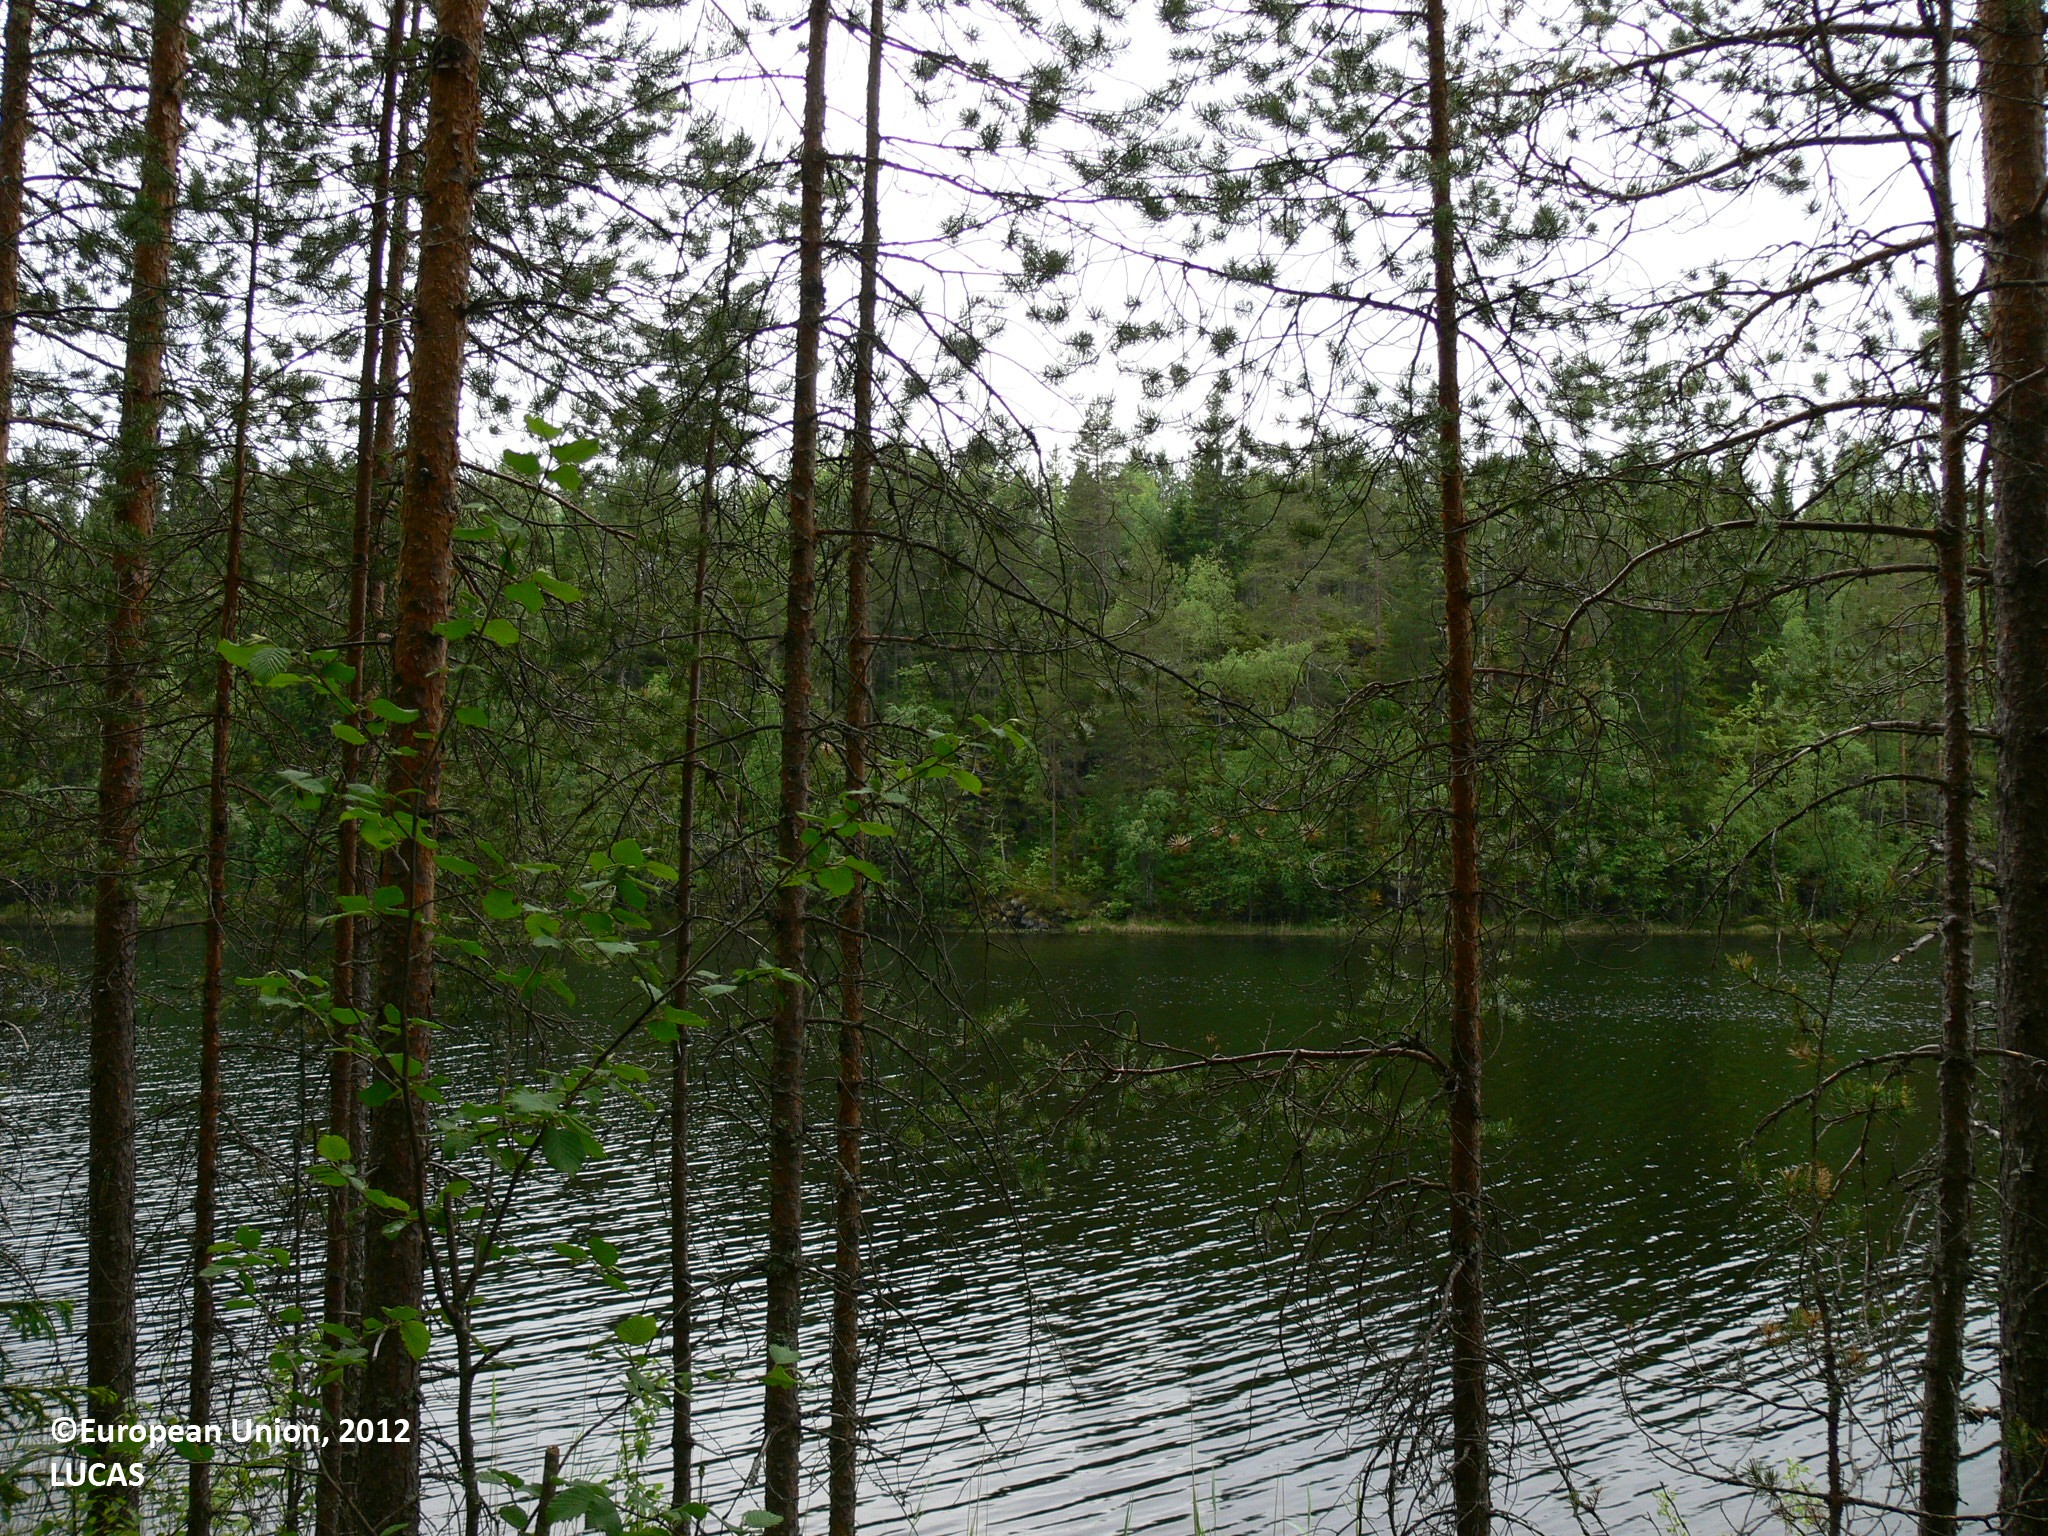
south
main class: Woodland
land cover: Pine dominated coniferous woodland
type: boreal forest
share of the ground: > 75 %
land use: Forestry
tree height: > 5 m
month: June
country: FI
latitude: 62.9290
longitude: 29.8872
